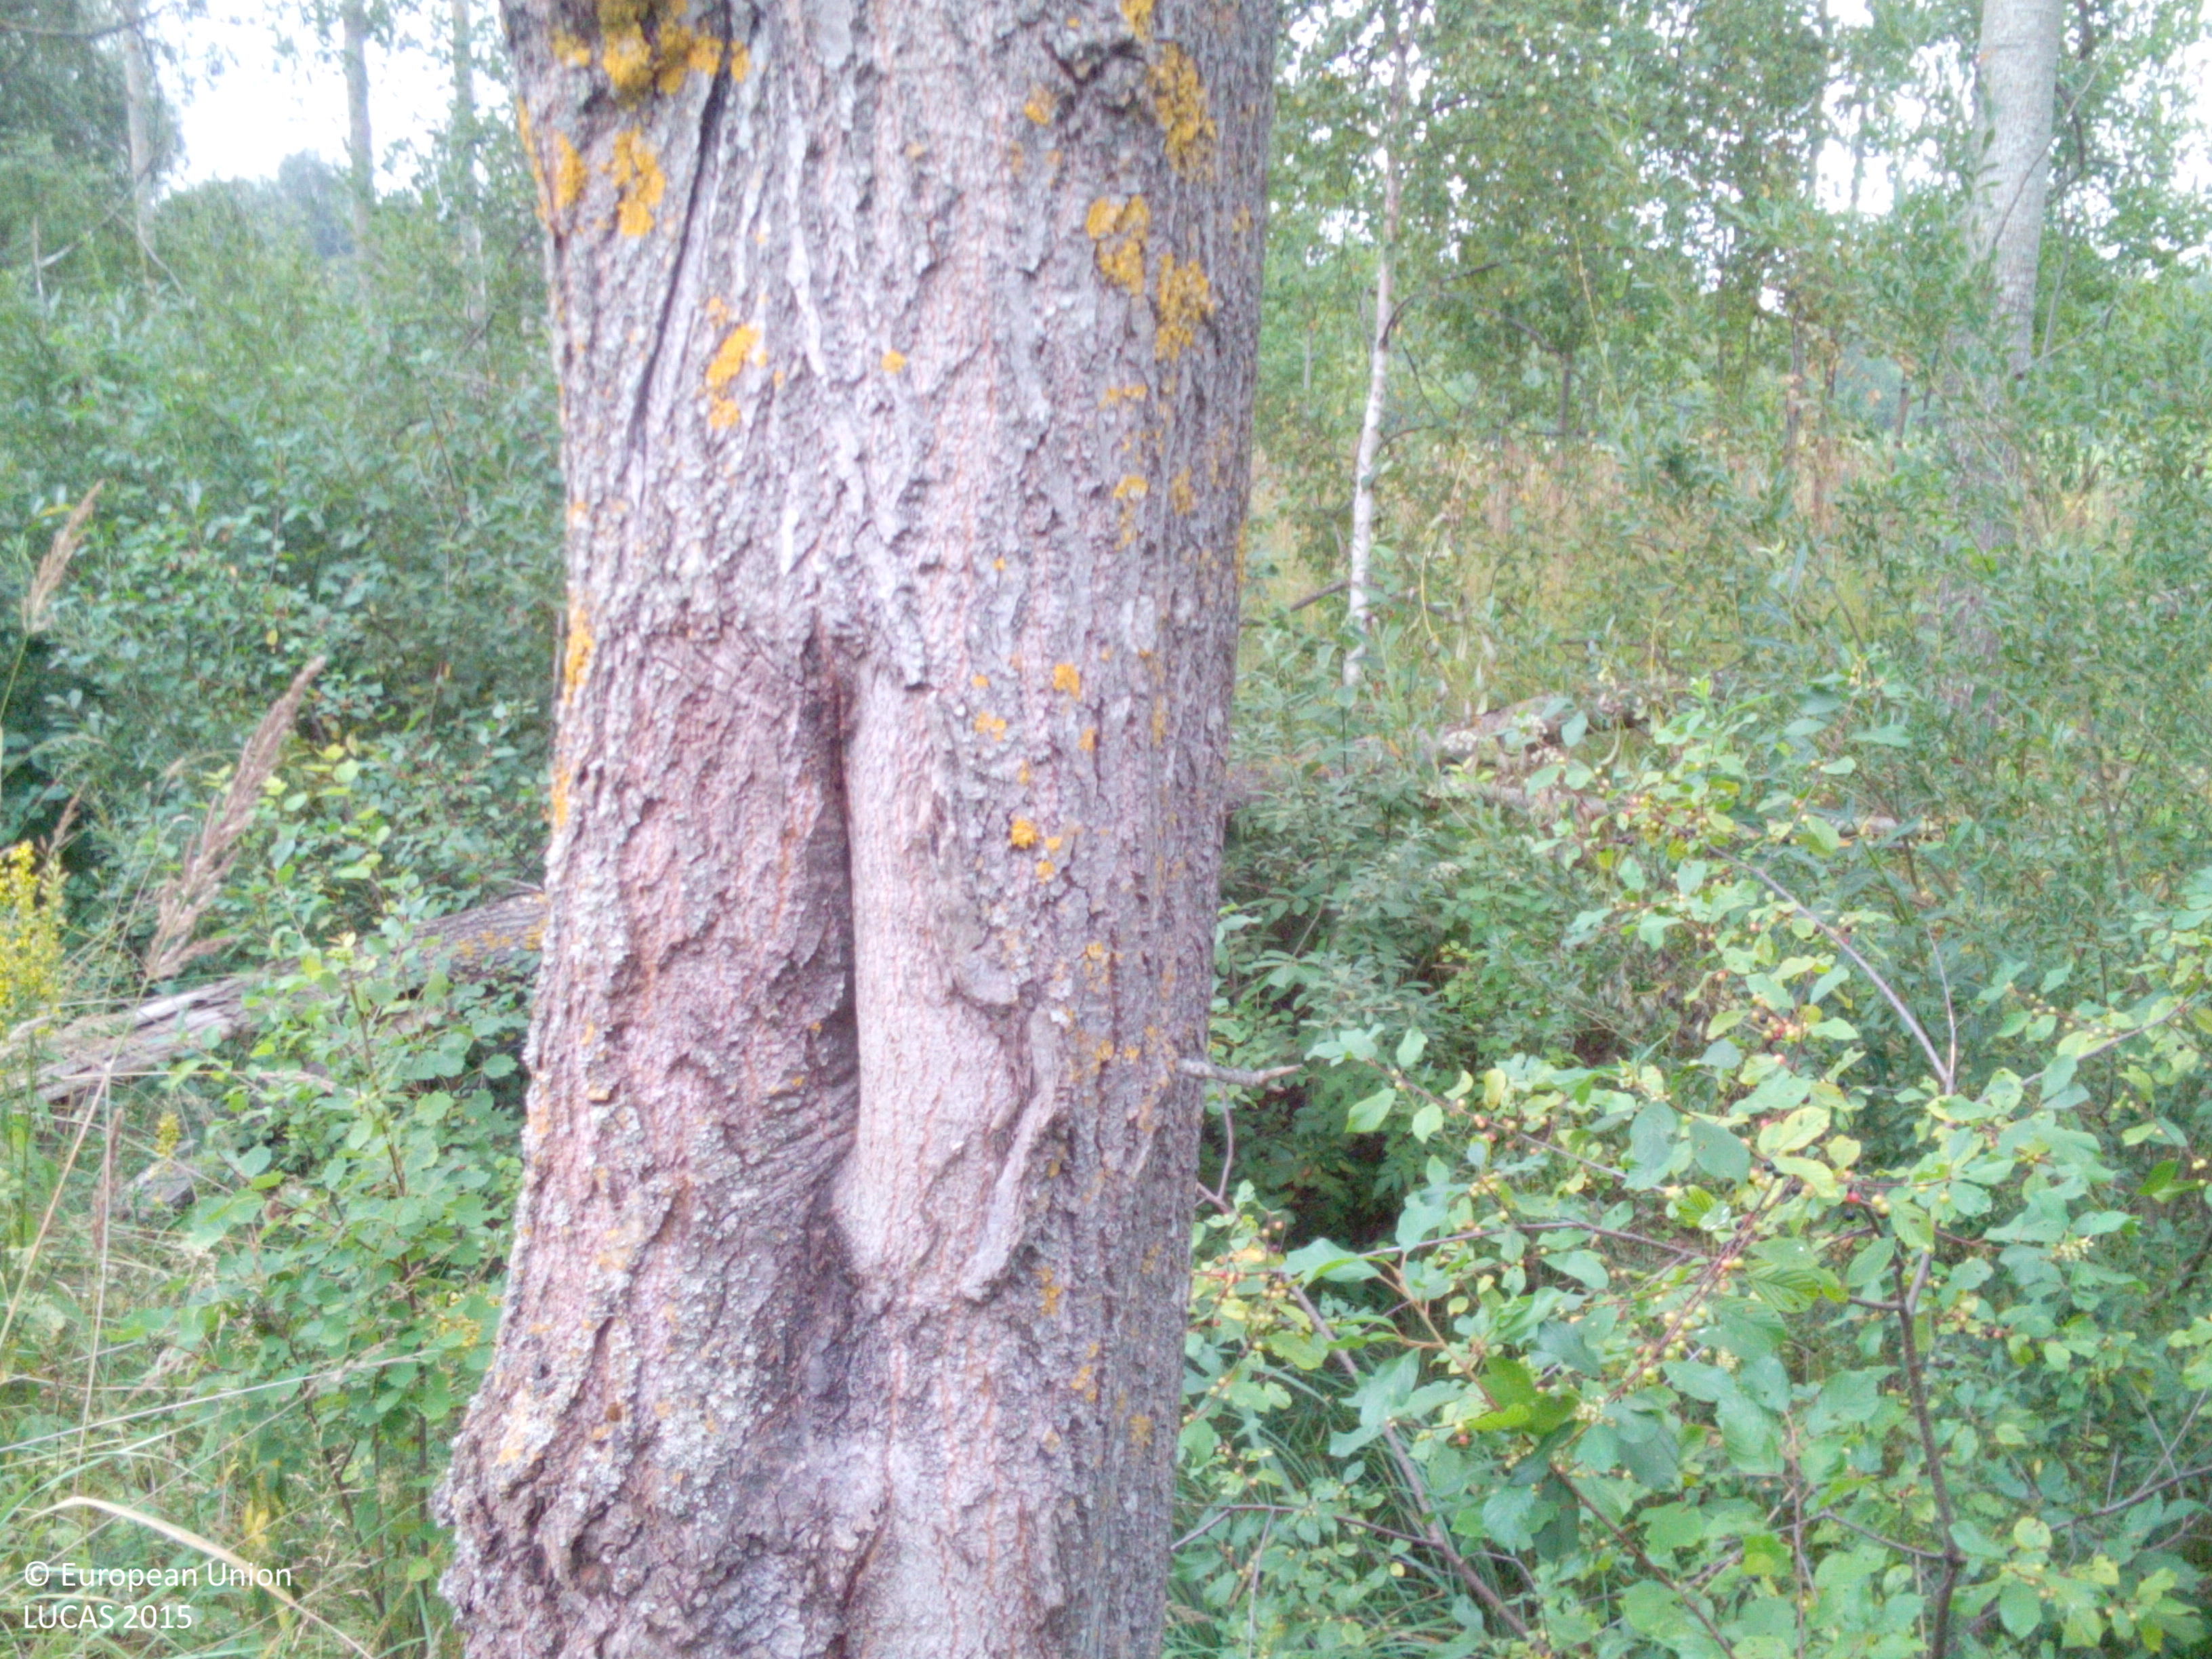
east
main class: Woodland
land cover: Broadleaved woodland
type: non-riverine alder, birch or aspen forest
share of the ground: 25 - 50 %
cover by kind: herbaceous plants 60 %, broadleaved forest trees 40 %
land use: Forestry
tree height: > 5 m
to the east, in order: Broadleaved woodland; Grassland without tree/shrub cover; Broadleaved woodland; Ditches and canals; Broadleaved woodland
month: August
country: LV
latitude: 56.2064
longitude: 21.1786
